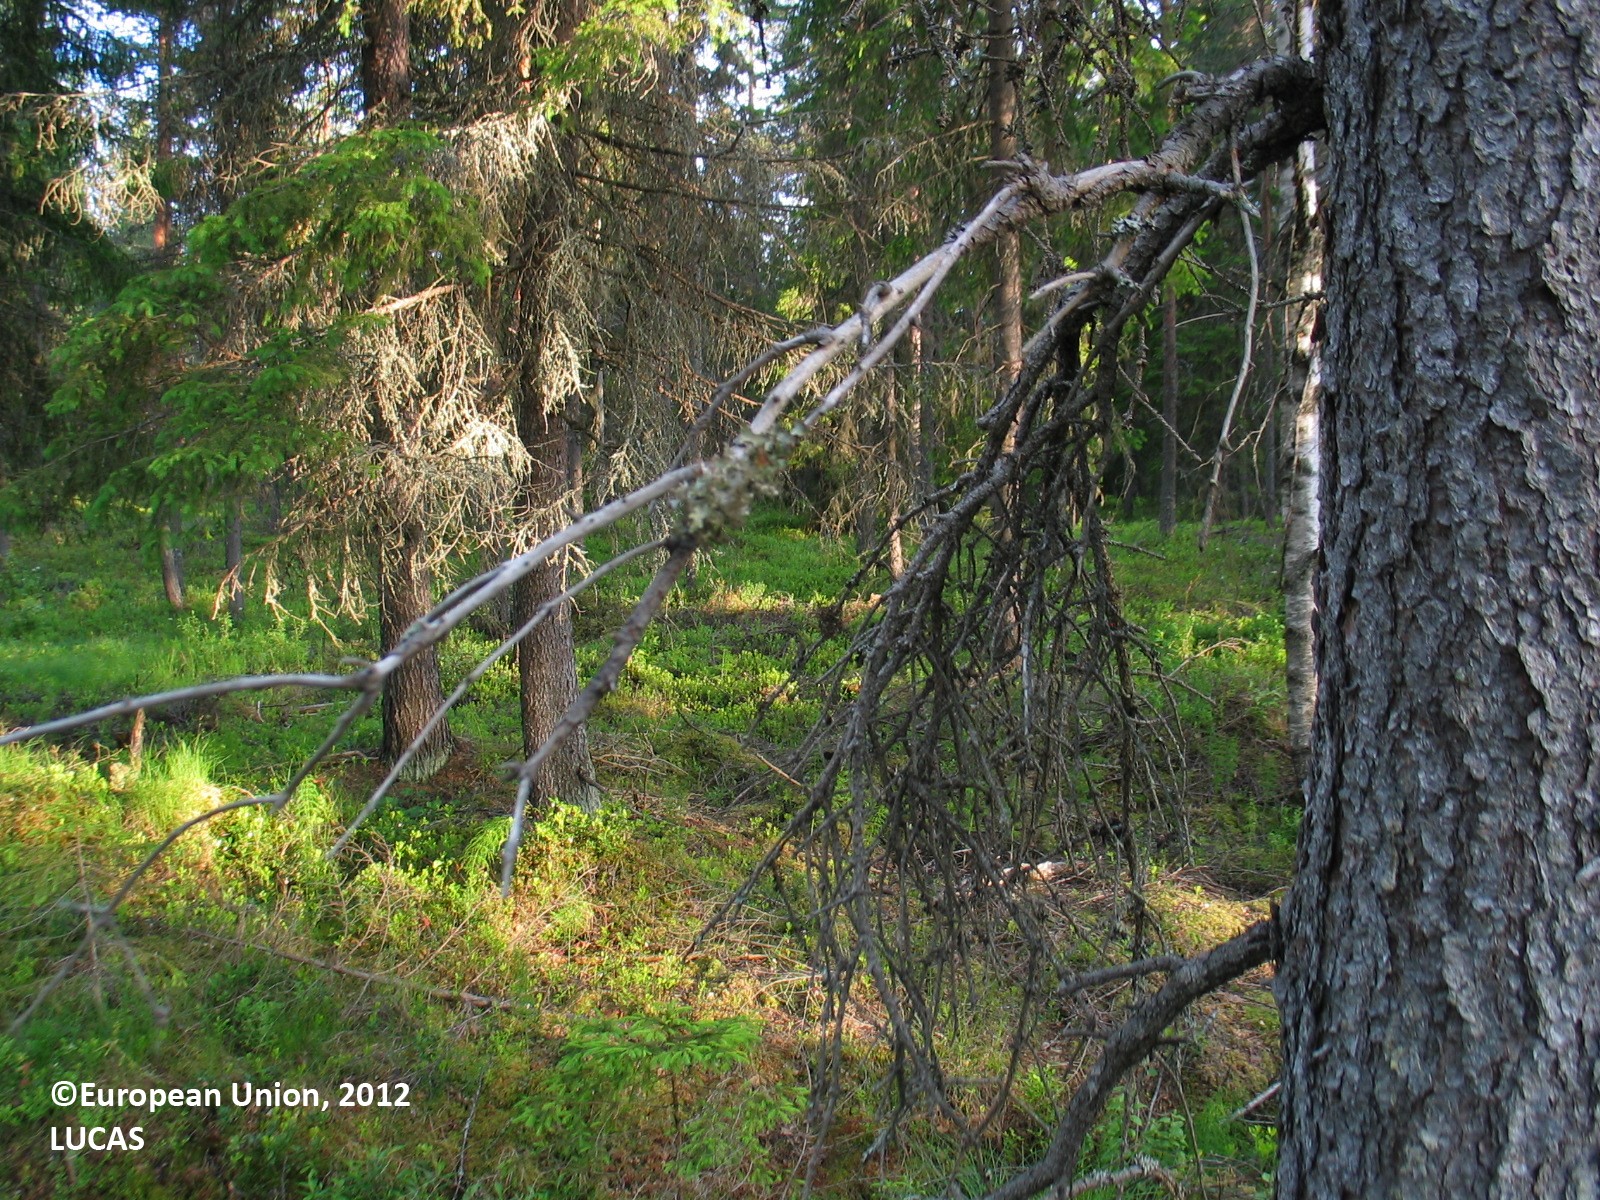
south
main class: Woodland
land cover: Other coniferous woodland
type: boreal forest
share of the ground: 25 - 50 %
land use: Forestry
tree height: > 5 m
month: June
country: FI
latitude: 64.9479
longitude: 26.5558
